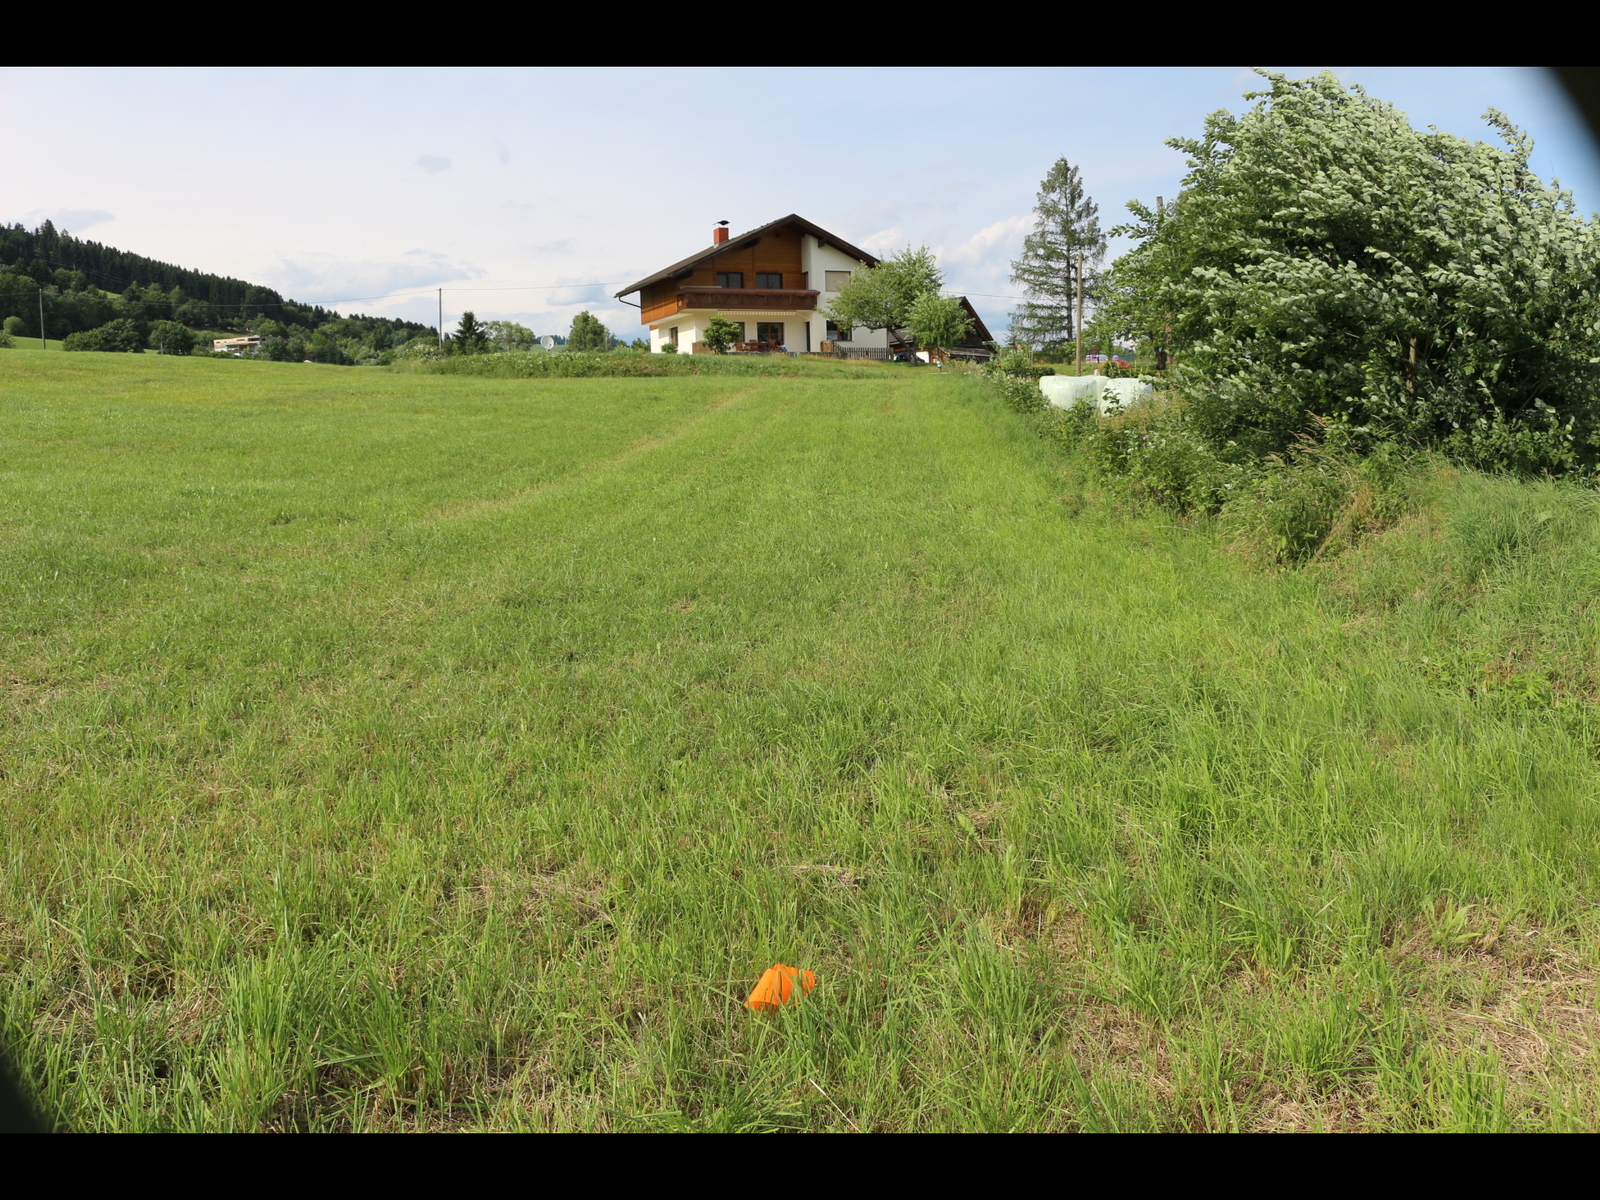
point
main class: Grassland
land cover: Grassland without tree/shrub cover
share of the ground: > 75 %
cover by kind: herbaceous plants 100 %
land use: Agriculture (excluding fallow land and kitchen gardens)
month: June
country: AT
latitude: 46.7257
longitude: 14.0406
